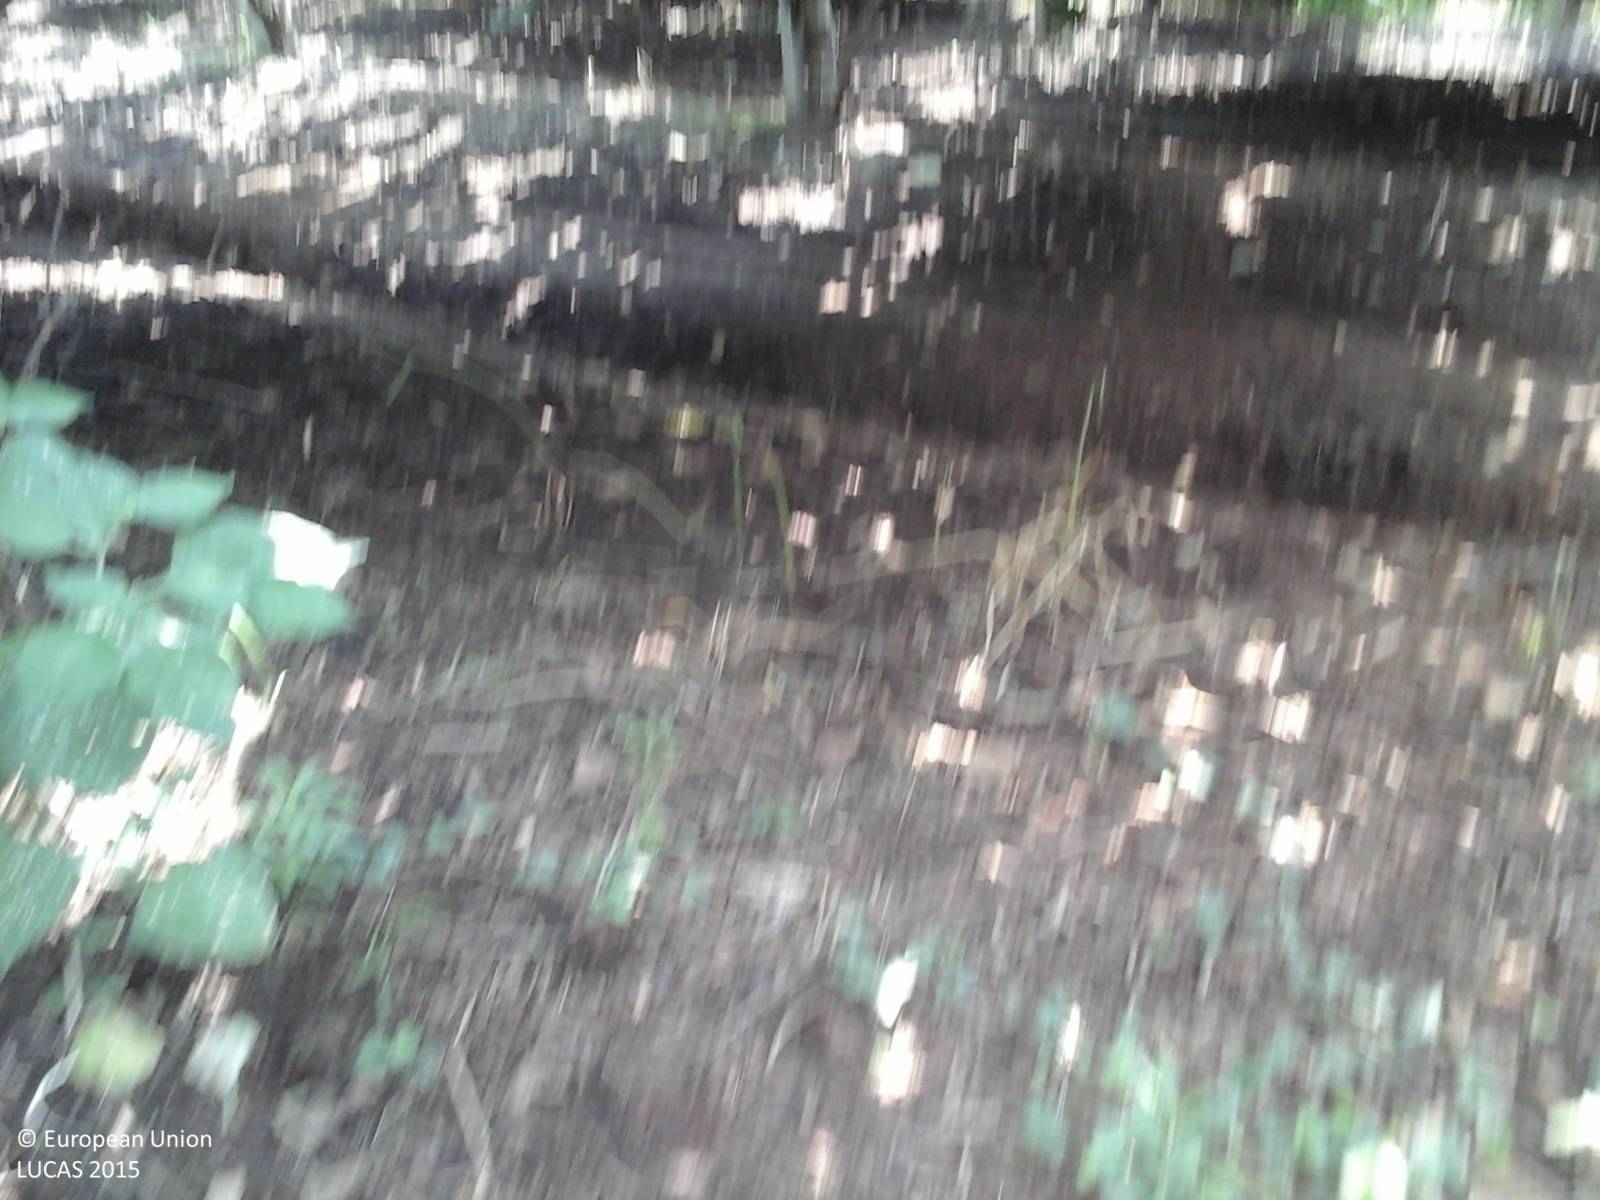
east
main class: Cropland
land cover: Other fruit trees and berries
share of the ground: > 75 %
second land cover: Other bare soil
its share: > 75 %
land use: Agriculture (excluding fallow land and kitchen gardens)
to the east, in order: Other fruit trees and berries; Other bare soil
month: July
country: IT
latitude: 41.5505
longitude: 12.7346
